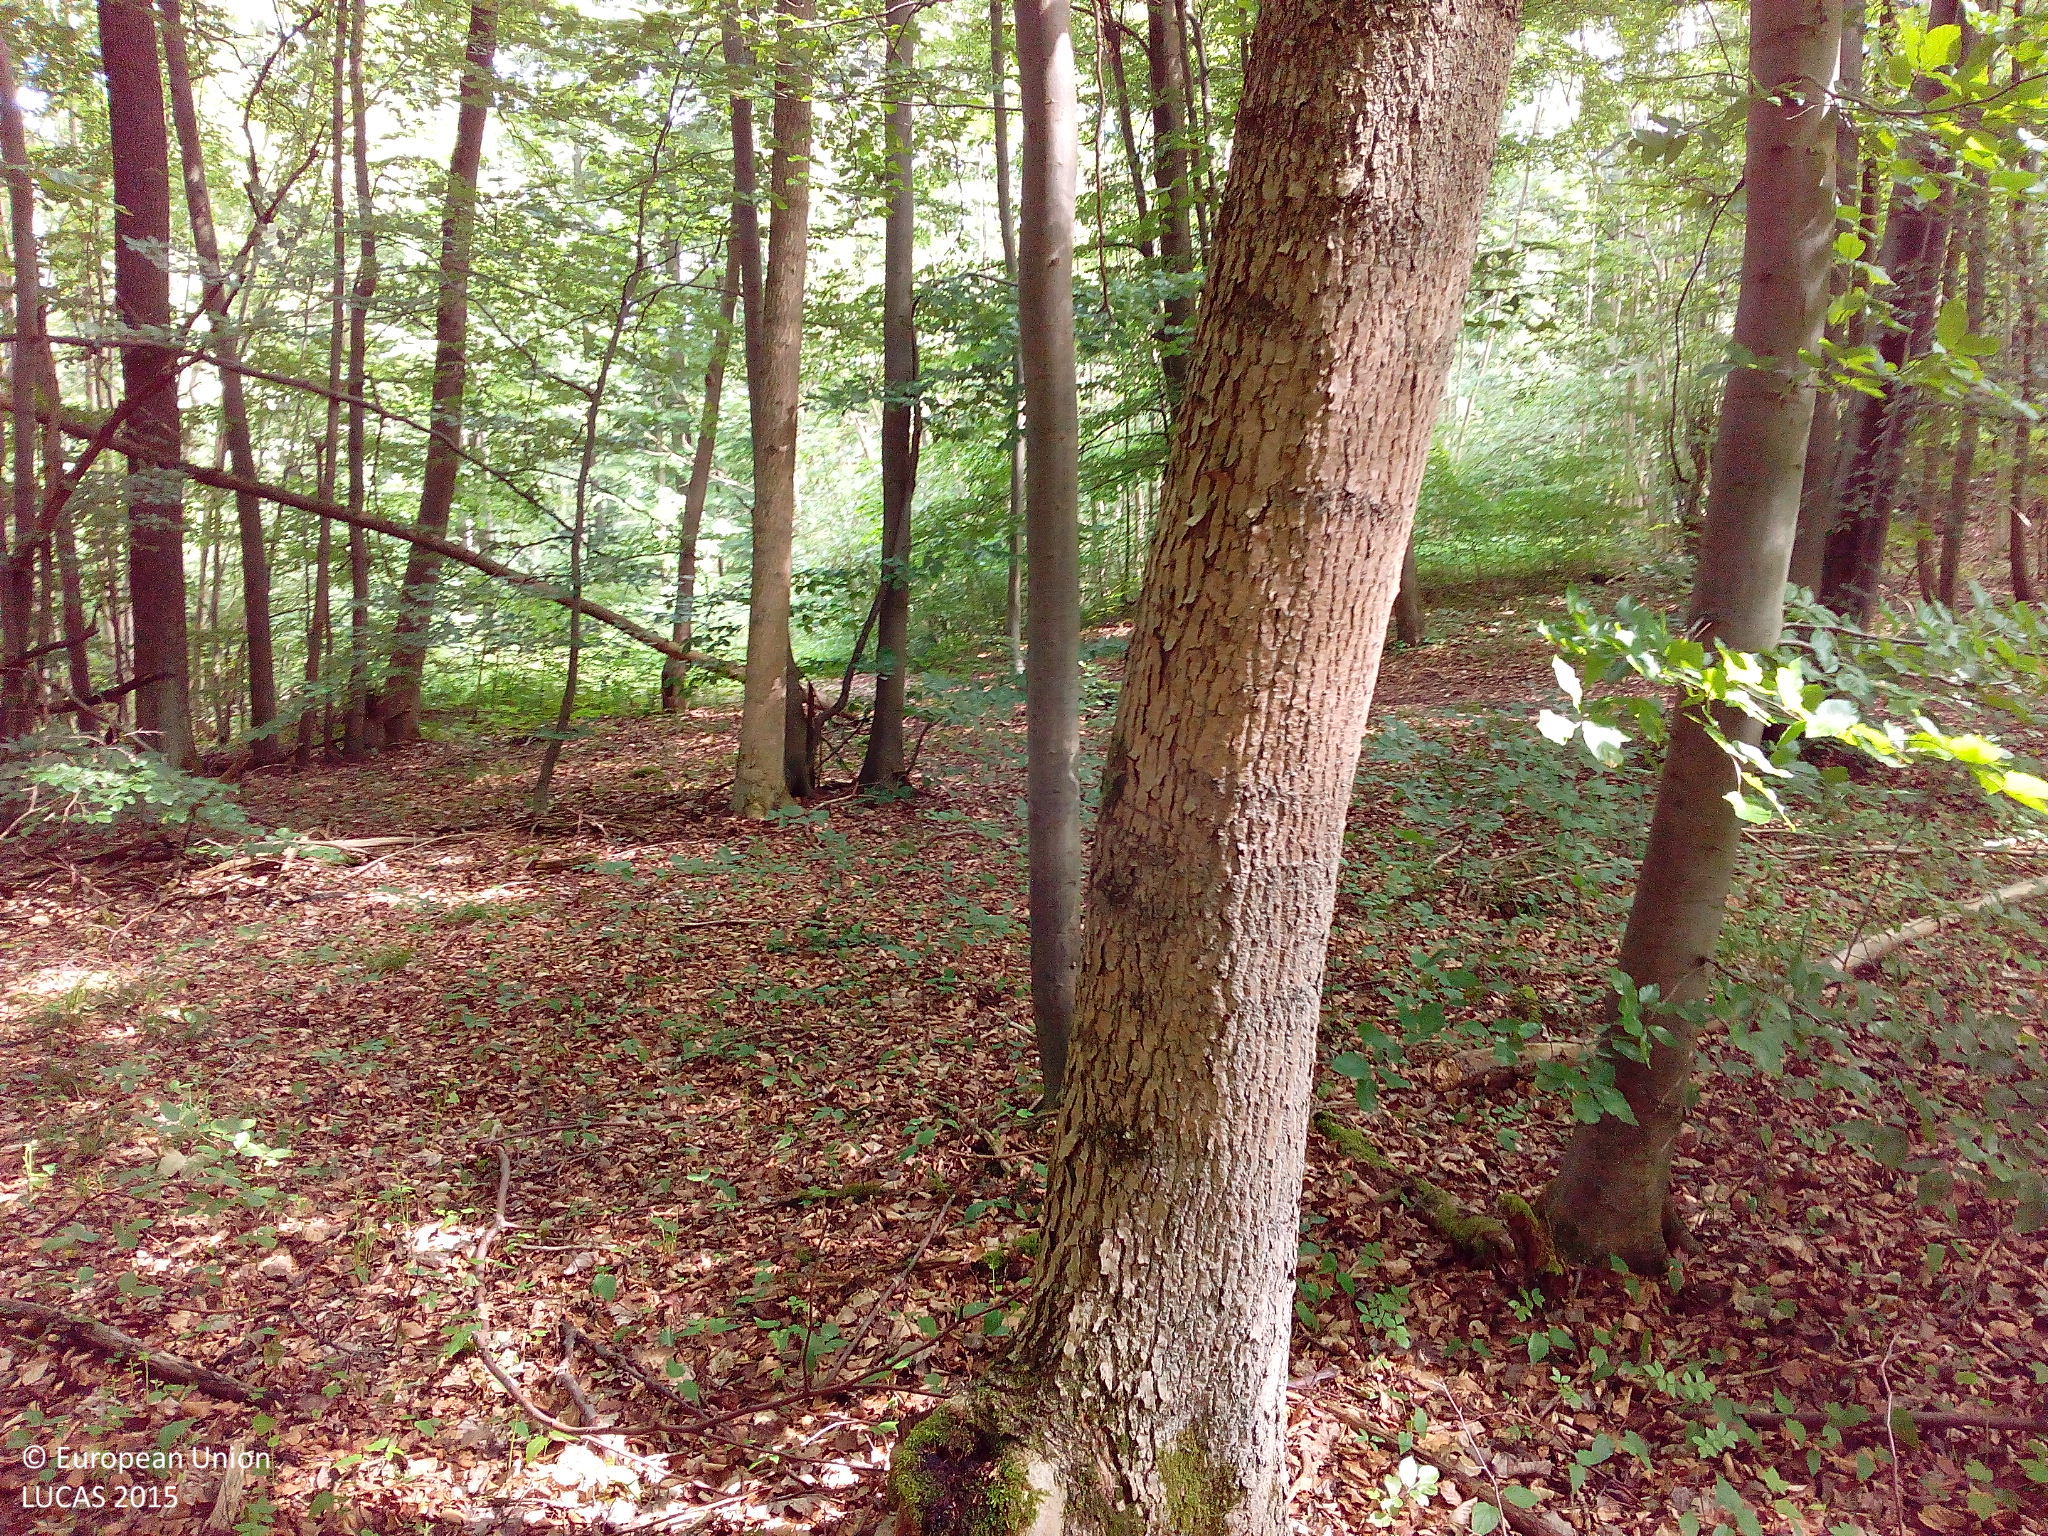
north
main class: Woodland
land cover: Broadleaved woodland
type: beech forest
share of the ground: > 75 %
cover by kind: broadleaved forest trees 100 %
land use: Forestry
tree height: > 5 m
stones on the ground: < 10 %
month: July
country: DE
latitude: 50.9933
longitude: 9.9288
